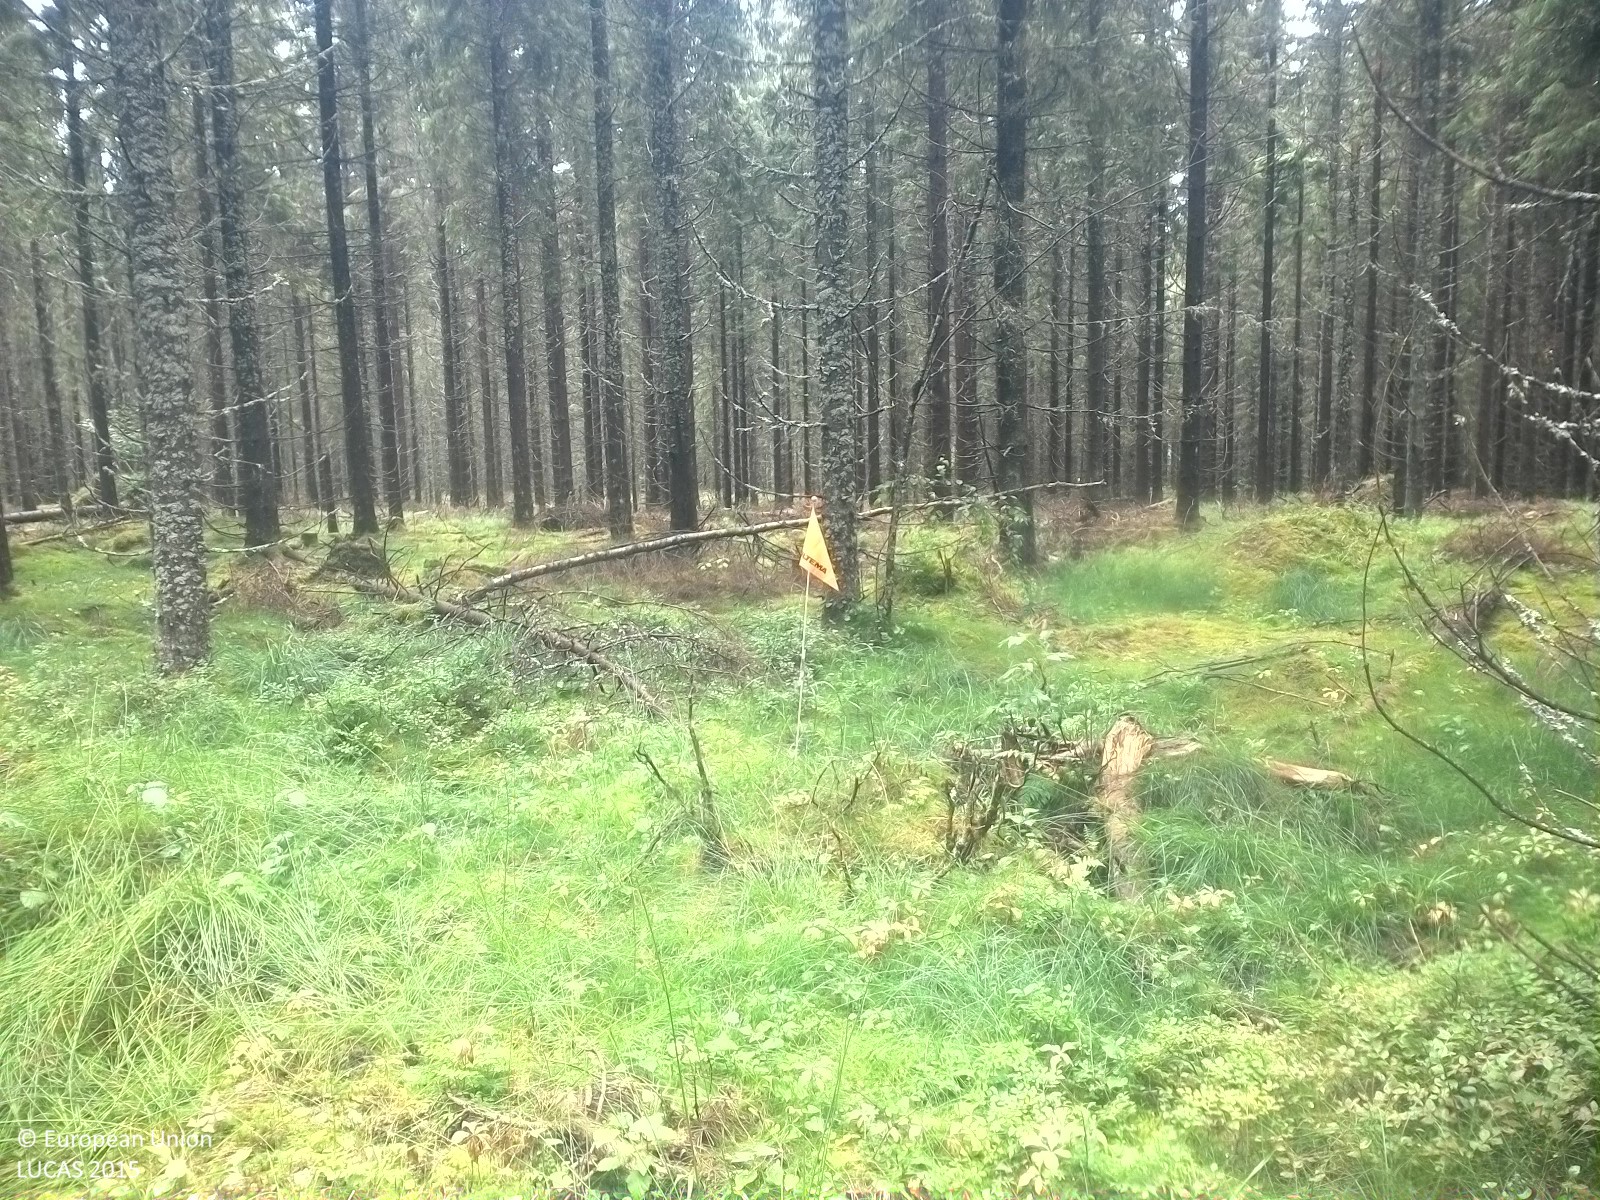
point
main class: Woodland
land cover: Spruce dominated coniferous woodland
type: boreal forest
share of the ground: 25 - 50 %
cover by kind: coniferous forest trees 40 %, lichens and mosses 35 %, herbaceous plants 25 %
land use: Forestry
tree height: > 5 m
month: July
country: SE
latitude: 58.8604
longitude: 15.1420
